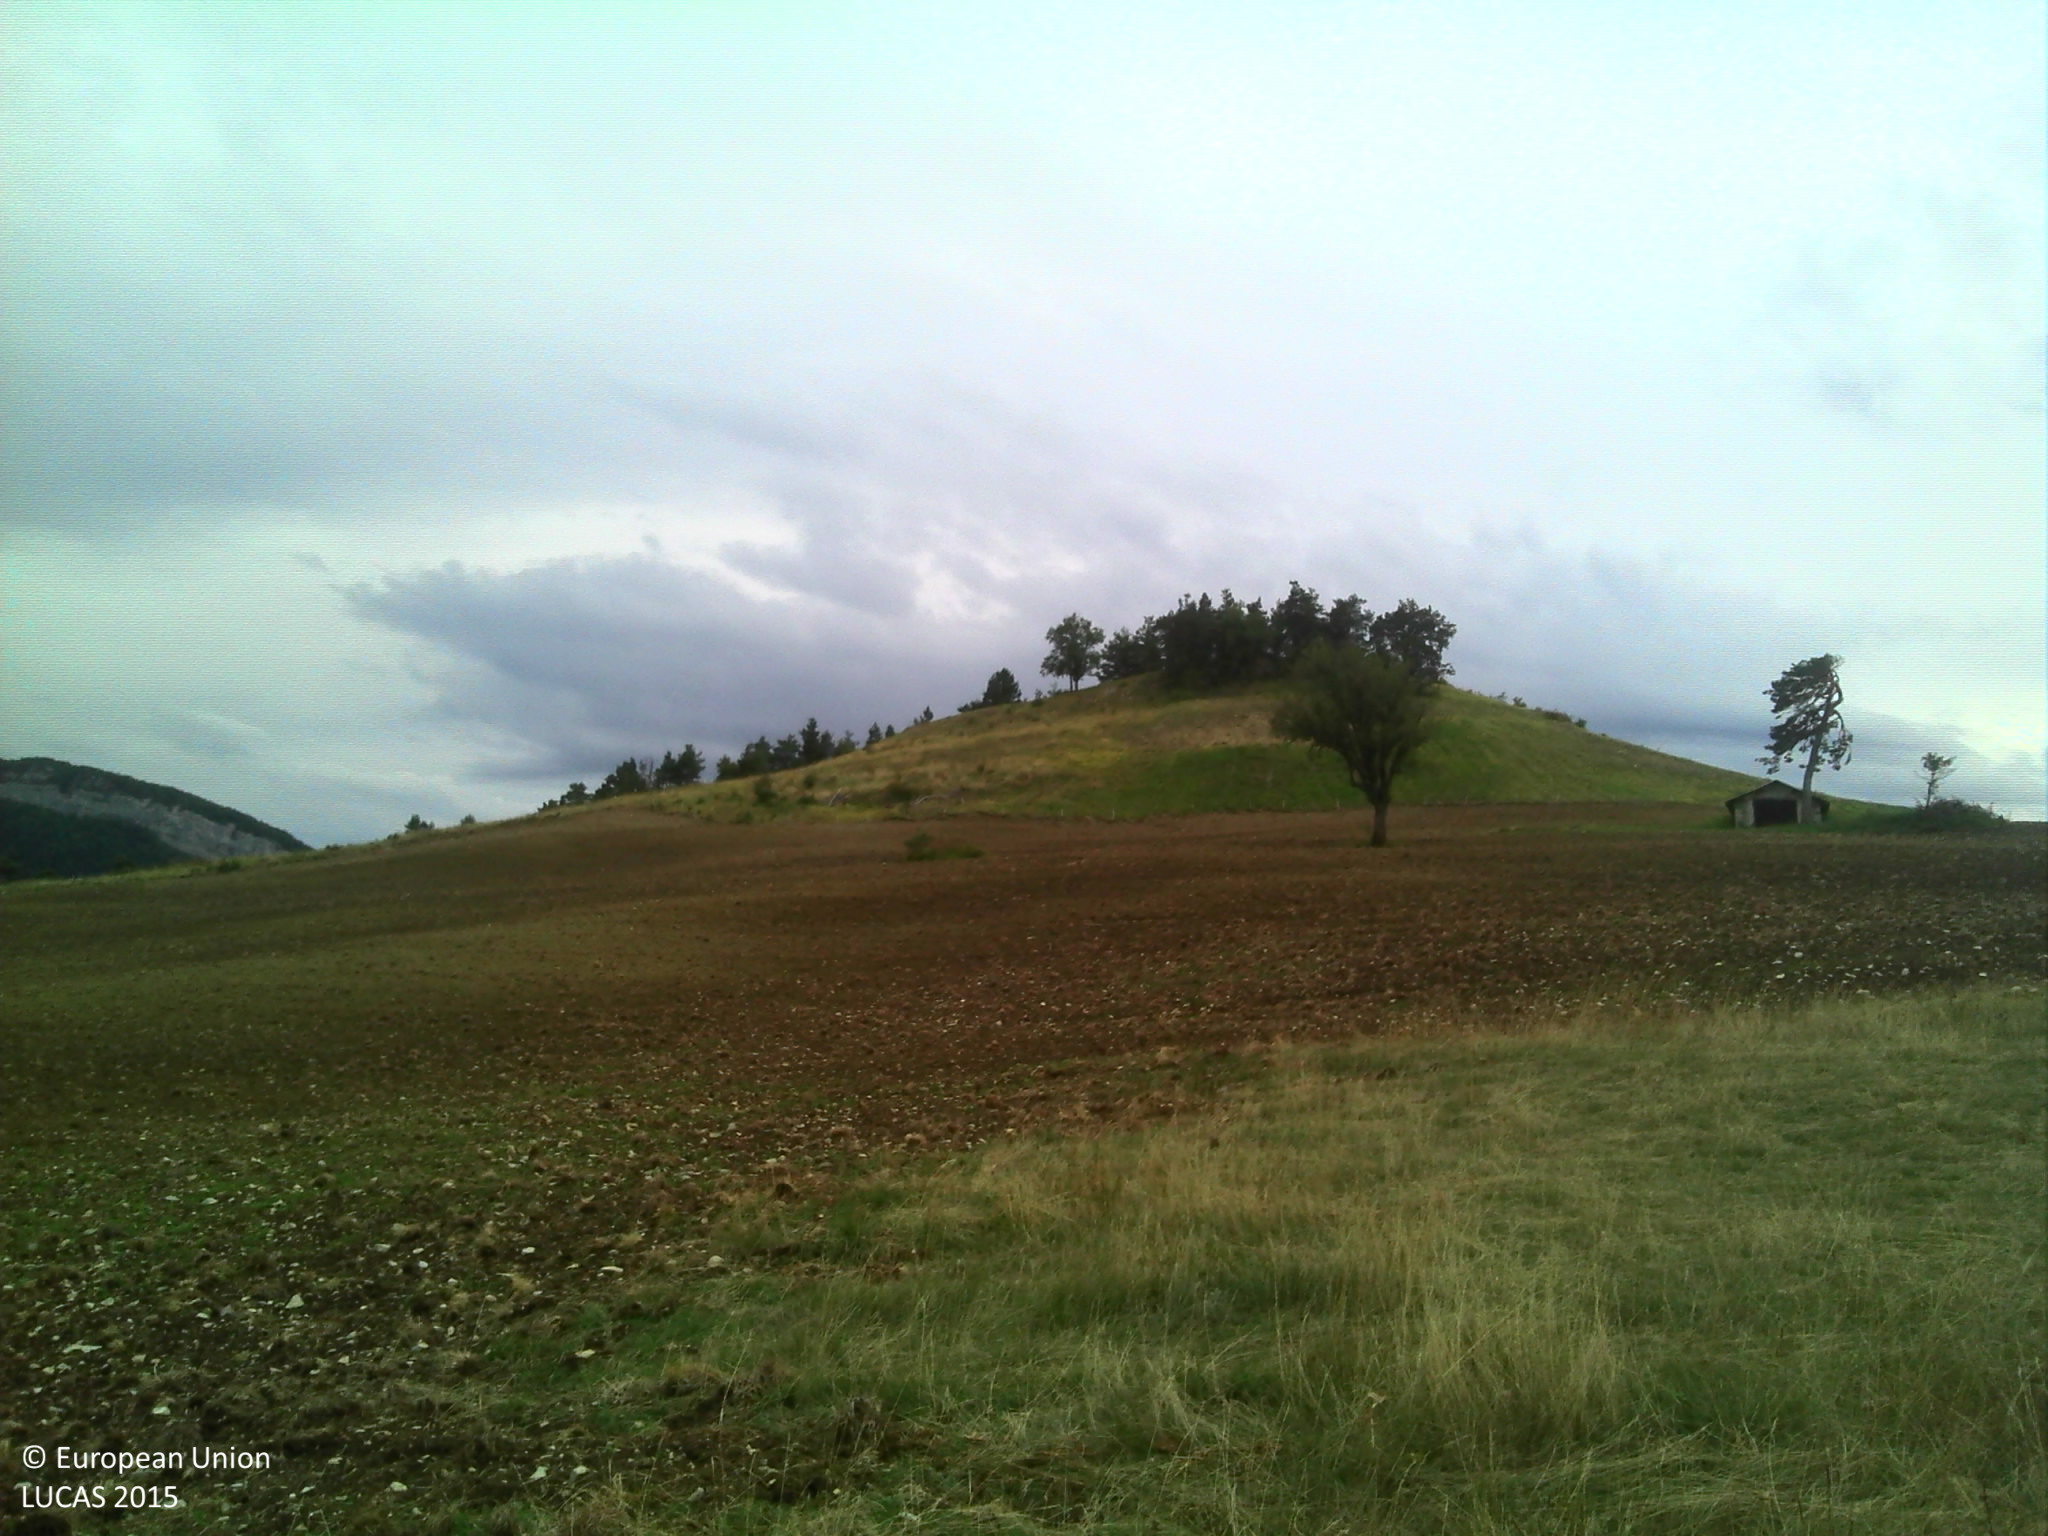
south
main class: Grassland
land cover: Grassland without tree/shrub cover
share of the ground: > 75 %
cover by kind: herbaceous plants 100 %
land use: Agriculture (excluding fallow land and kitchen gardens)
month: September
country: FR
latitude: 44.5796
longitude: 5.5359
